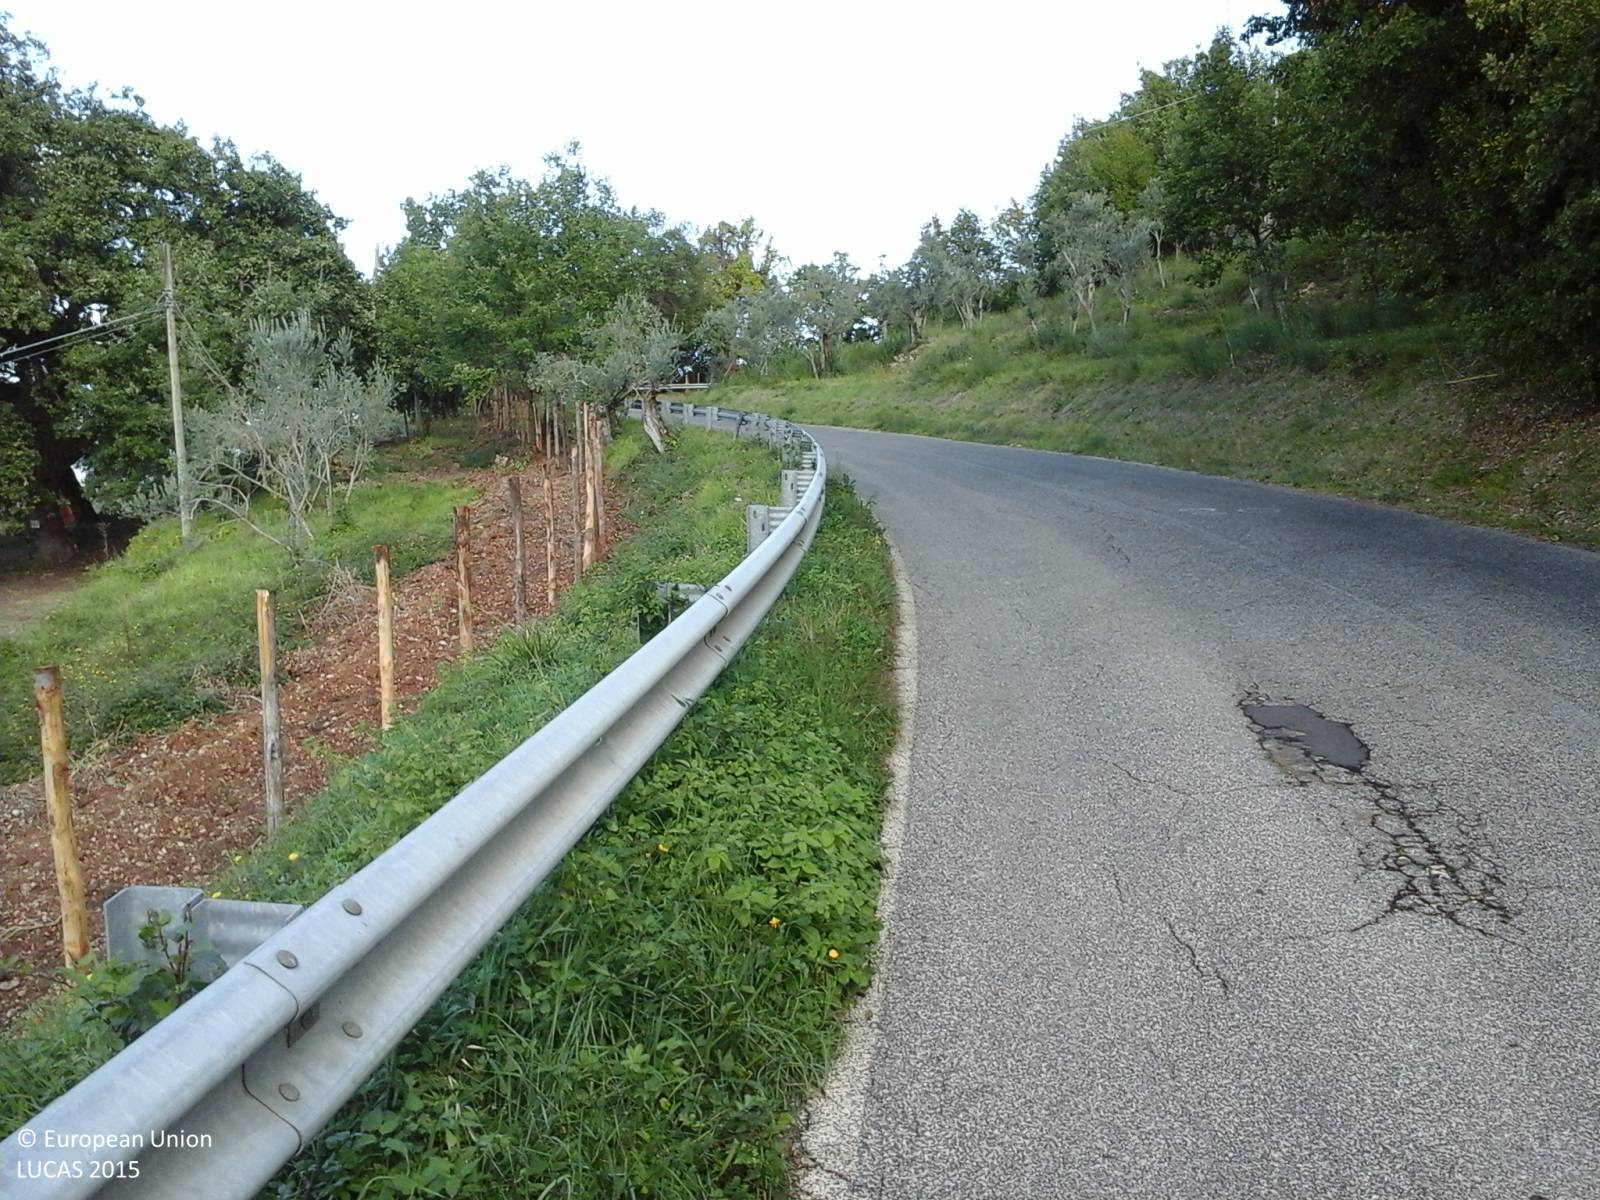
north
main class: Woodland
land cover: Broadleaved woodland
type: thermophilous deciduous forest
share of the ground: > 75 %
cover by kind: broadleaved forest trees 95 %, shrubs 5 %
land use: Forestry
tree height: > 5 m
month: October
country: IT
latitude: 42.4326
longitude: 12.8714
